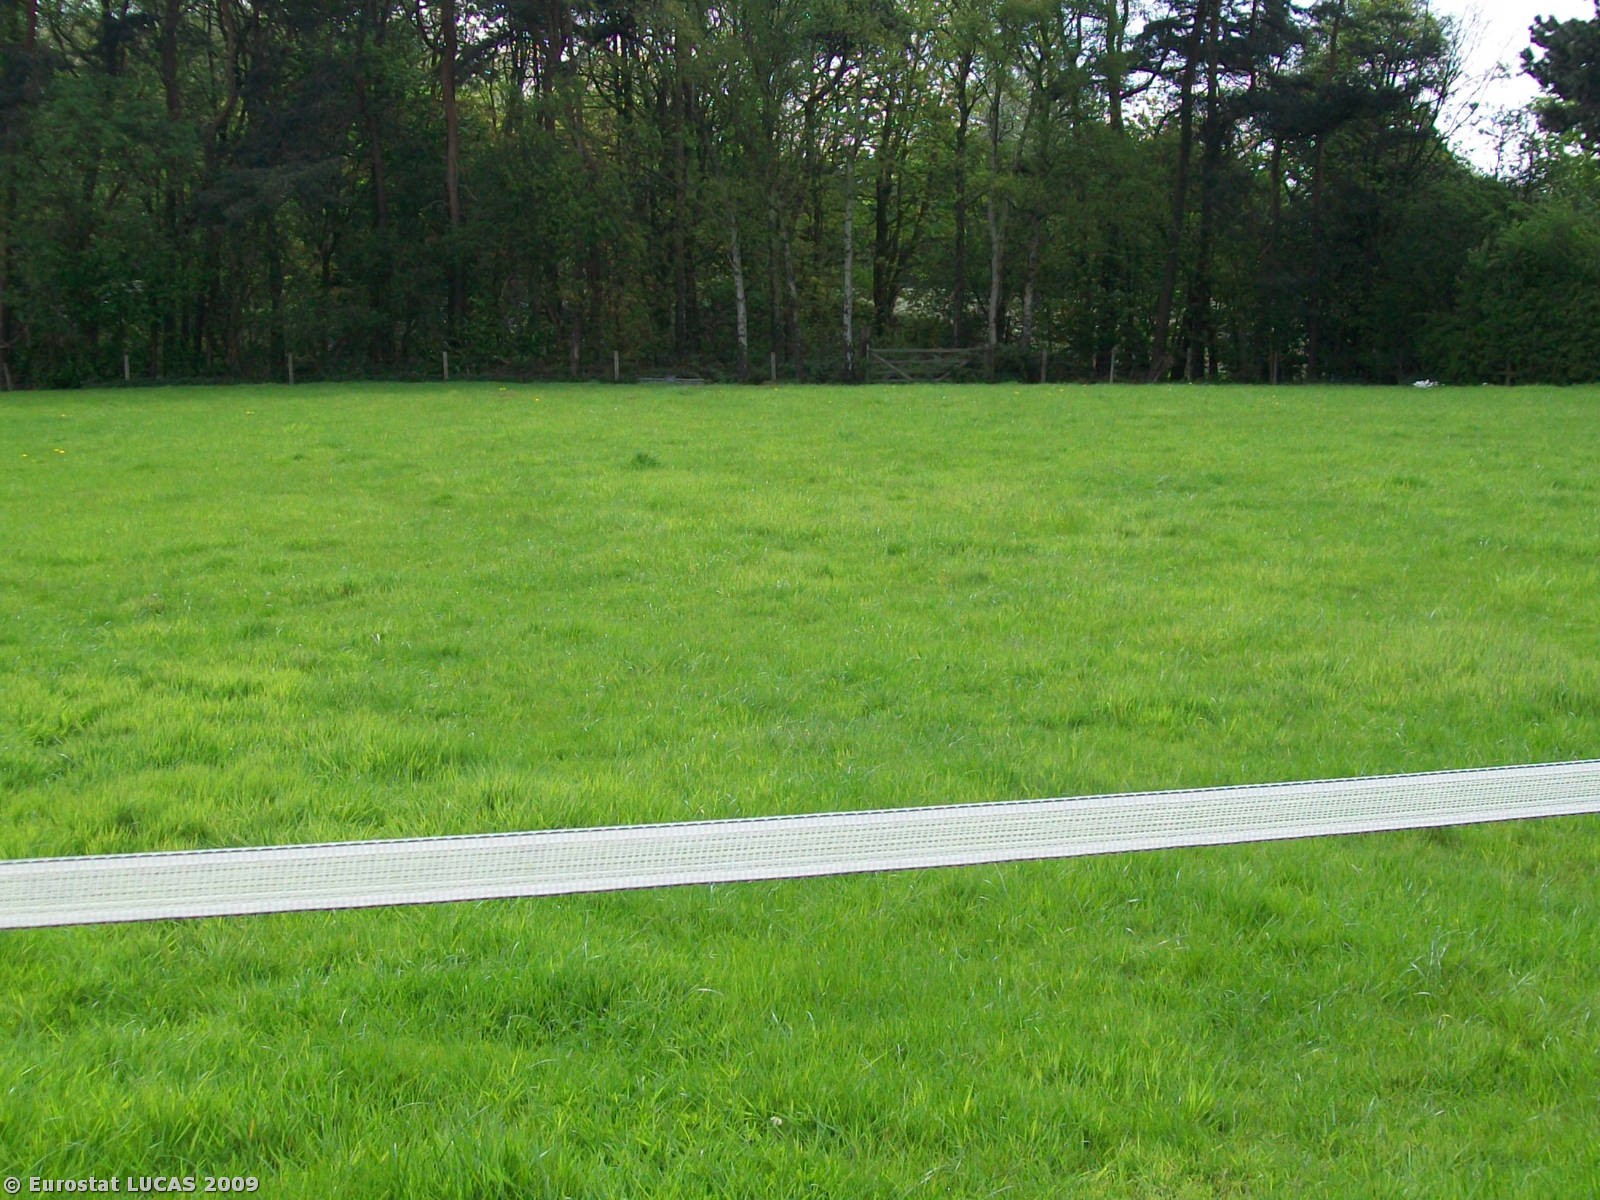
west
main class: Grassland
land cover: Grassland without tree/shrub cover
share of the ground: 50 - 75 %
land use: Agriculture (excluding fallow land and kitchen gardens)
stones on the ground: < 10 %
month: April
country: GB
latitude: 53.5447
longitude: -2.9153
